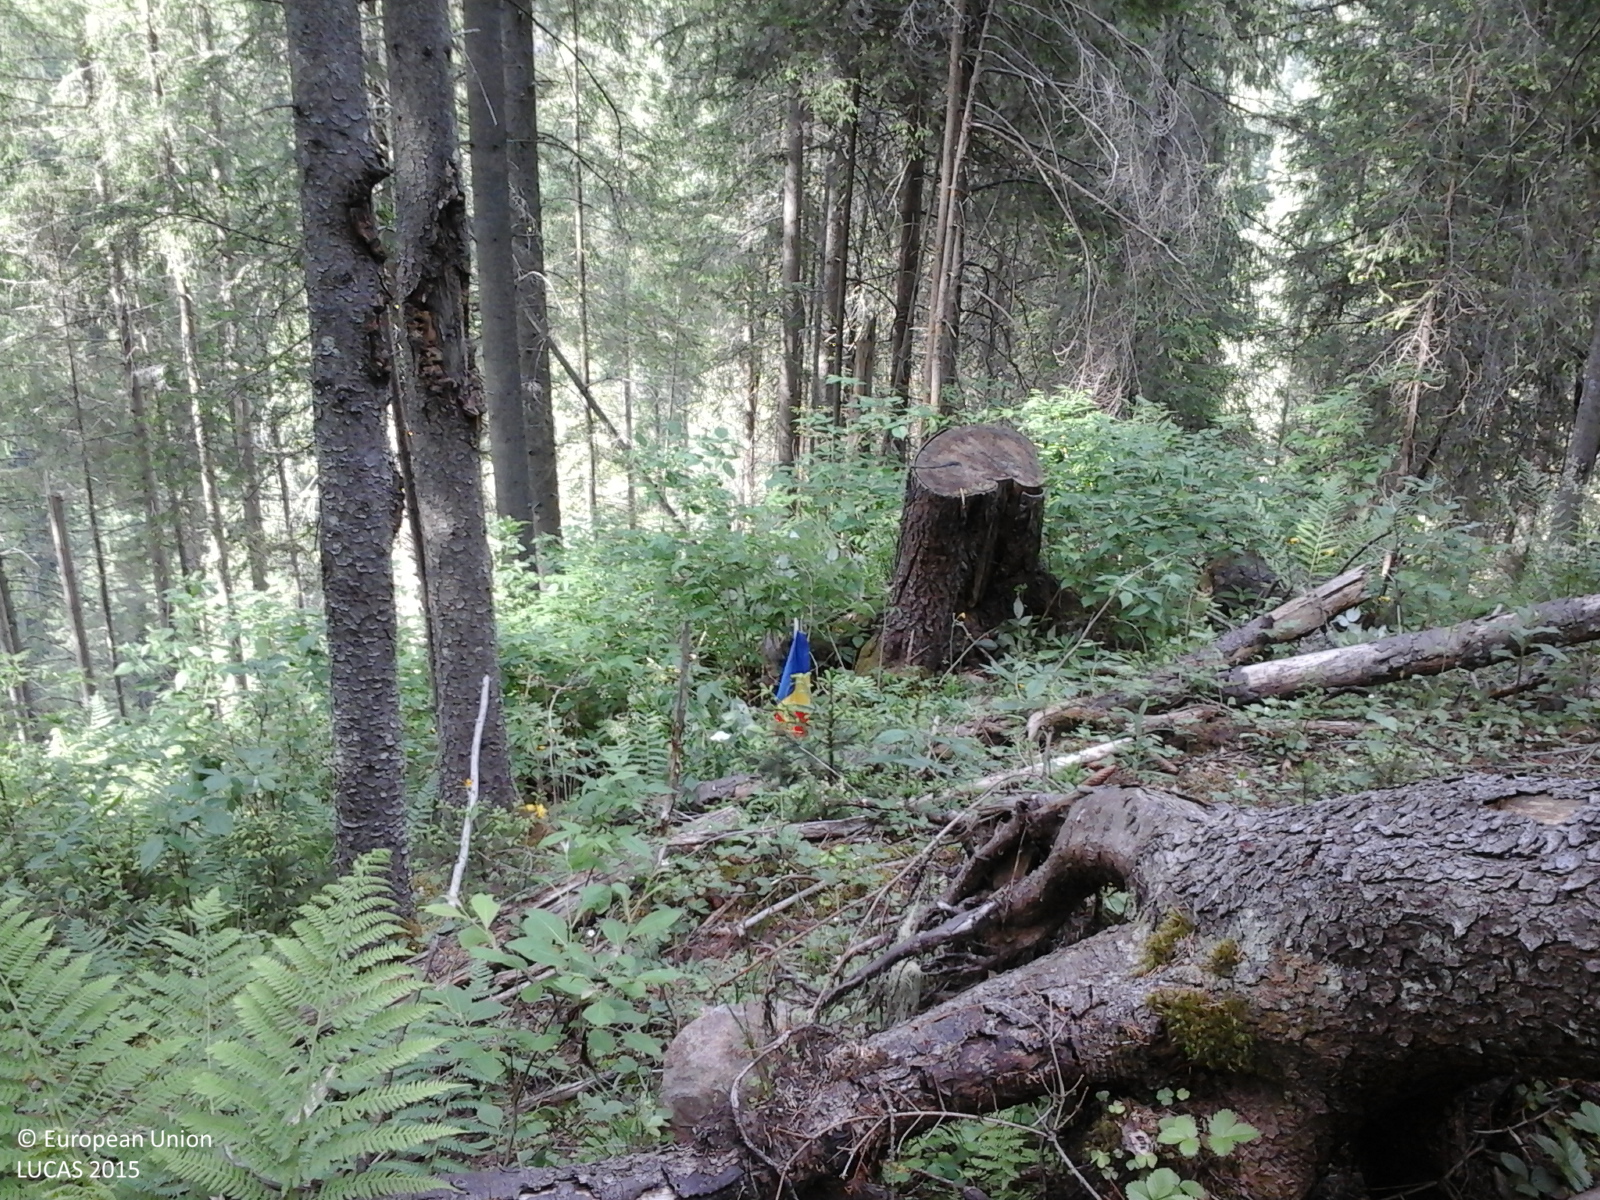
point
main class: Woodland
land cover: Spruce dominated coniferous woodland
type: alpine coniferous forest
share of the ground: > 75 %
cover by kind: coniferous forest trees 100 %
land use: Forestry
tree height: > 5 m
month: June
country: RO
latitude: 47.1895
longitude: 25.5161
